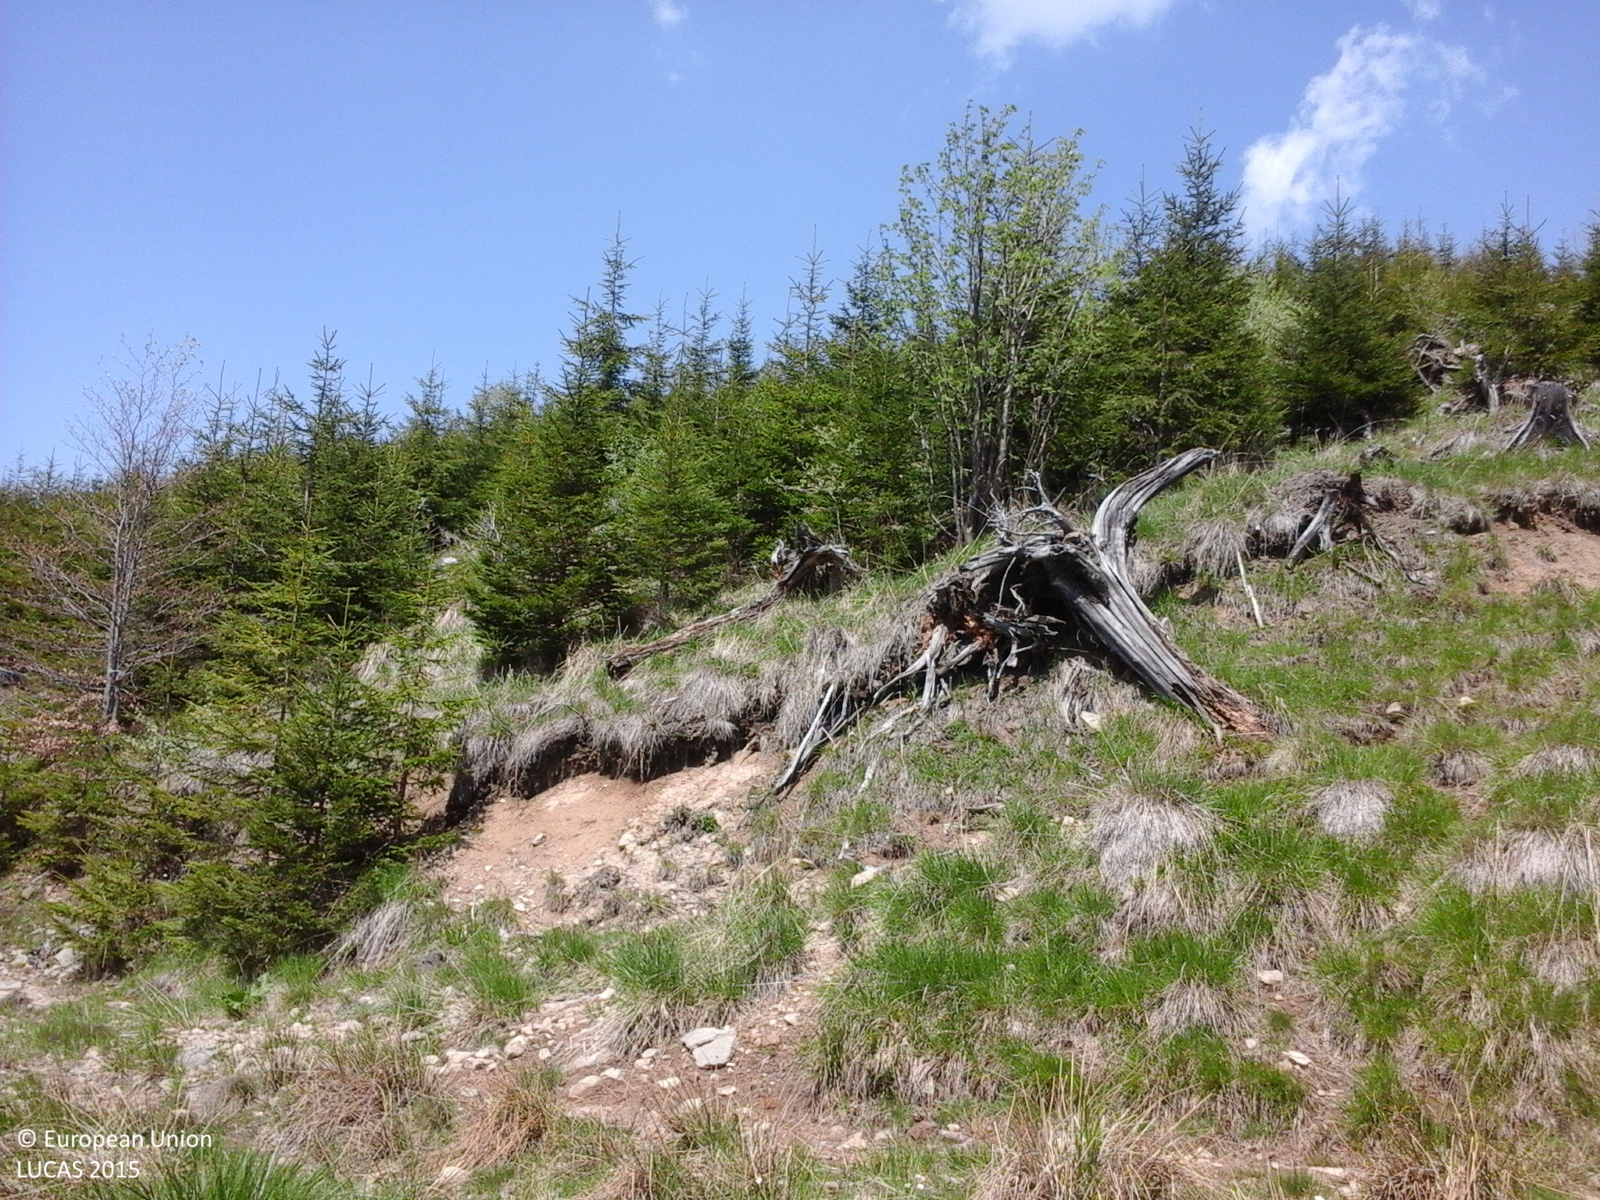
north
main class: Woodland
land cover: Spruce dominated mixed woodland
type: alpine coniferous forest
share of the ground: > 75 %
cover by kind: coniferous forest trees 75 %, broadleaved forest trees 25 %
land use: Forestry
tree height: > 5 m
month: May
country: RO
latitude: 45.8631
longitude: 26.2885
